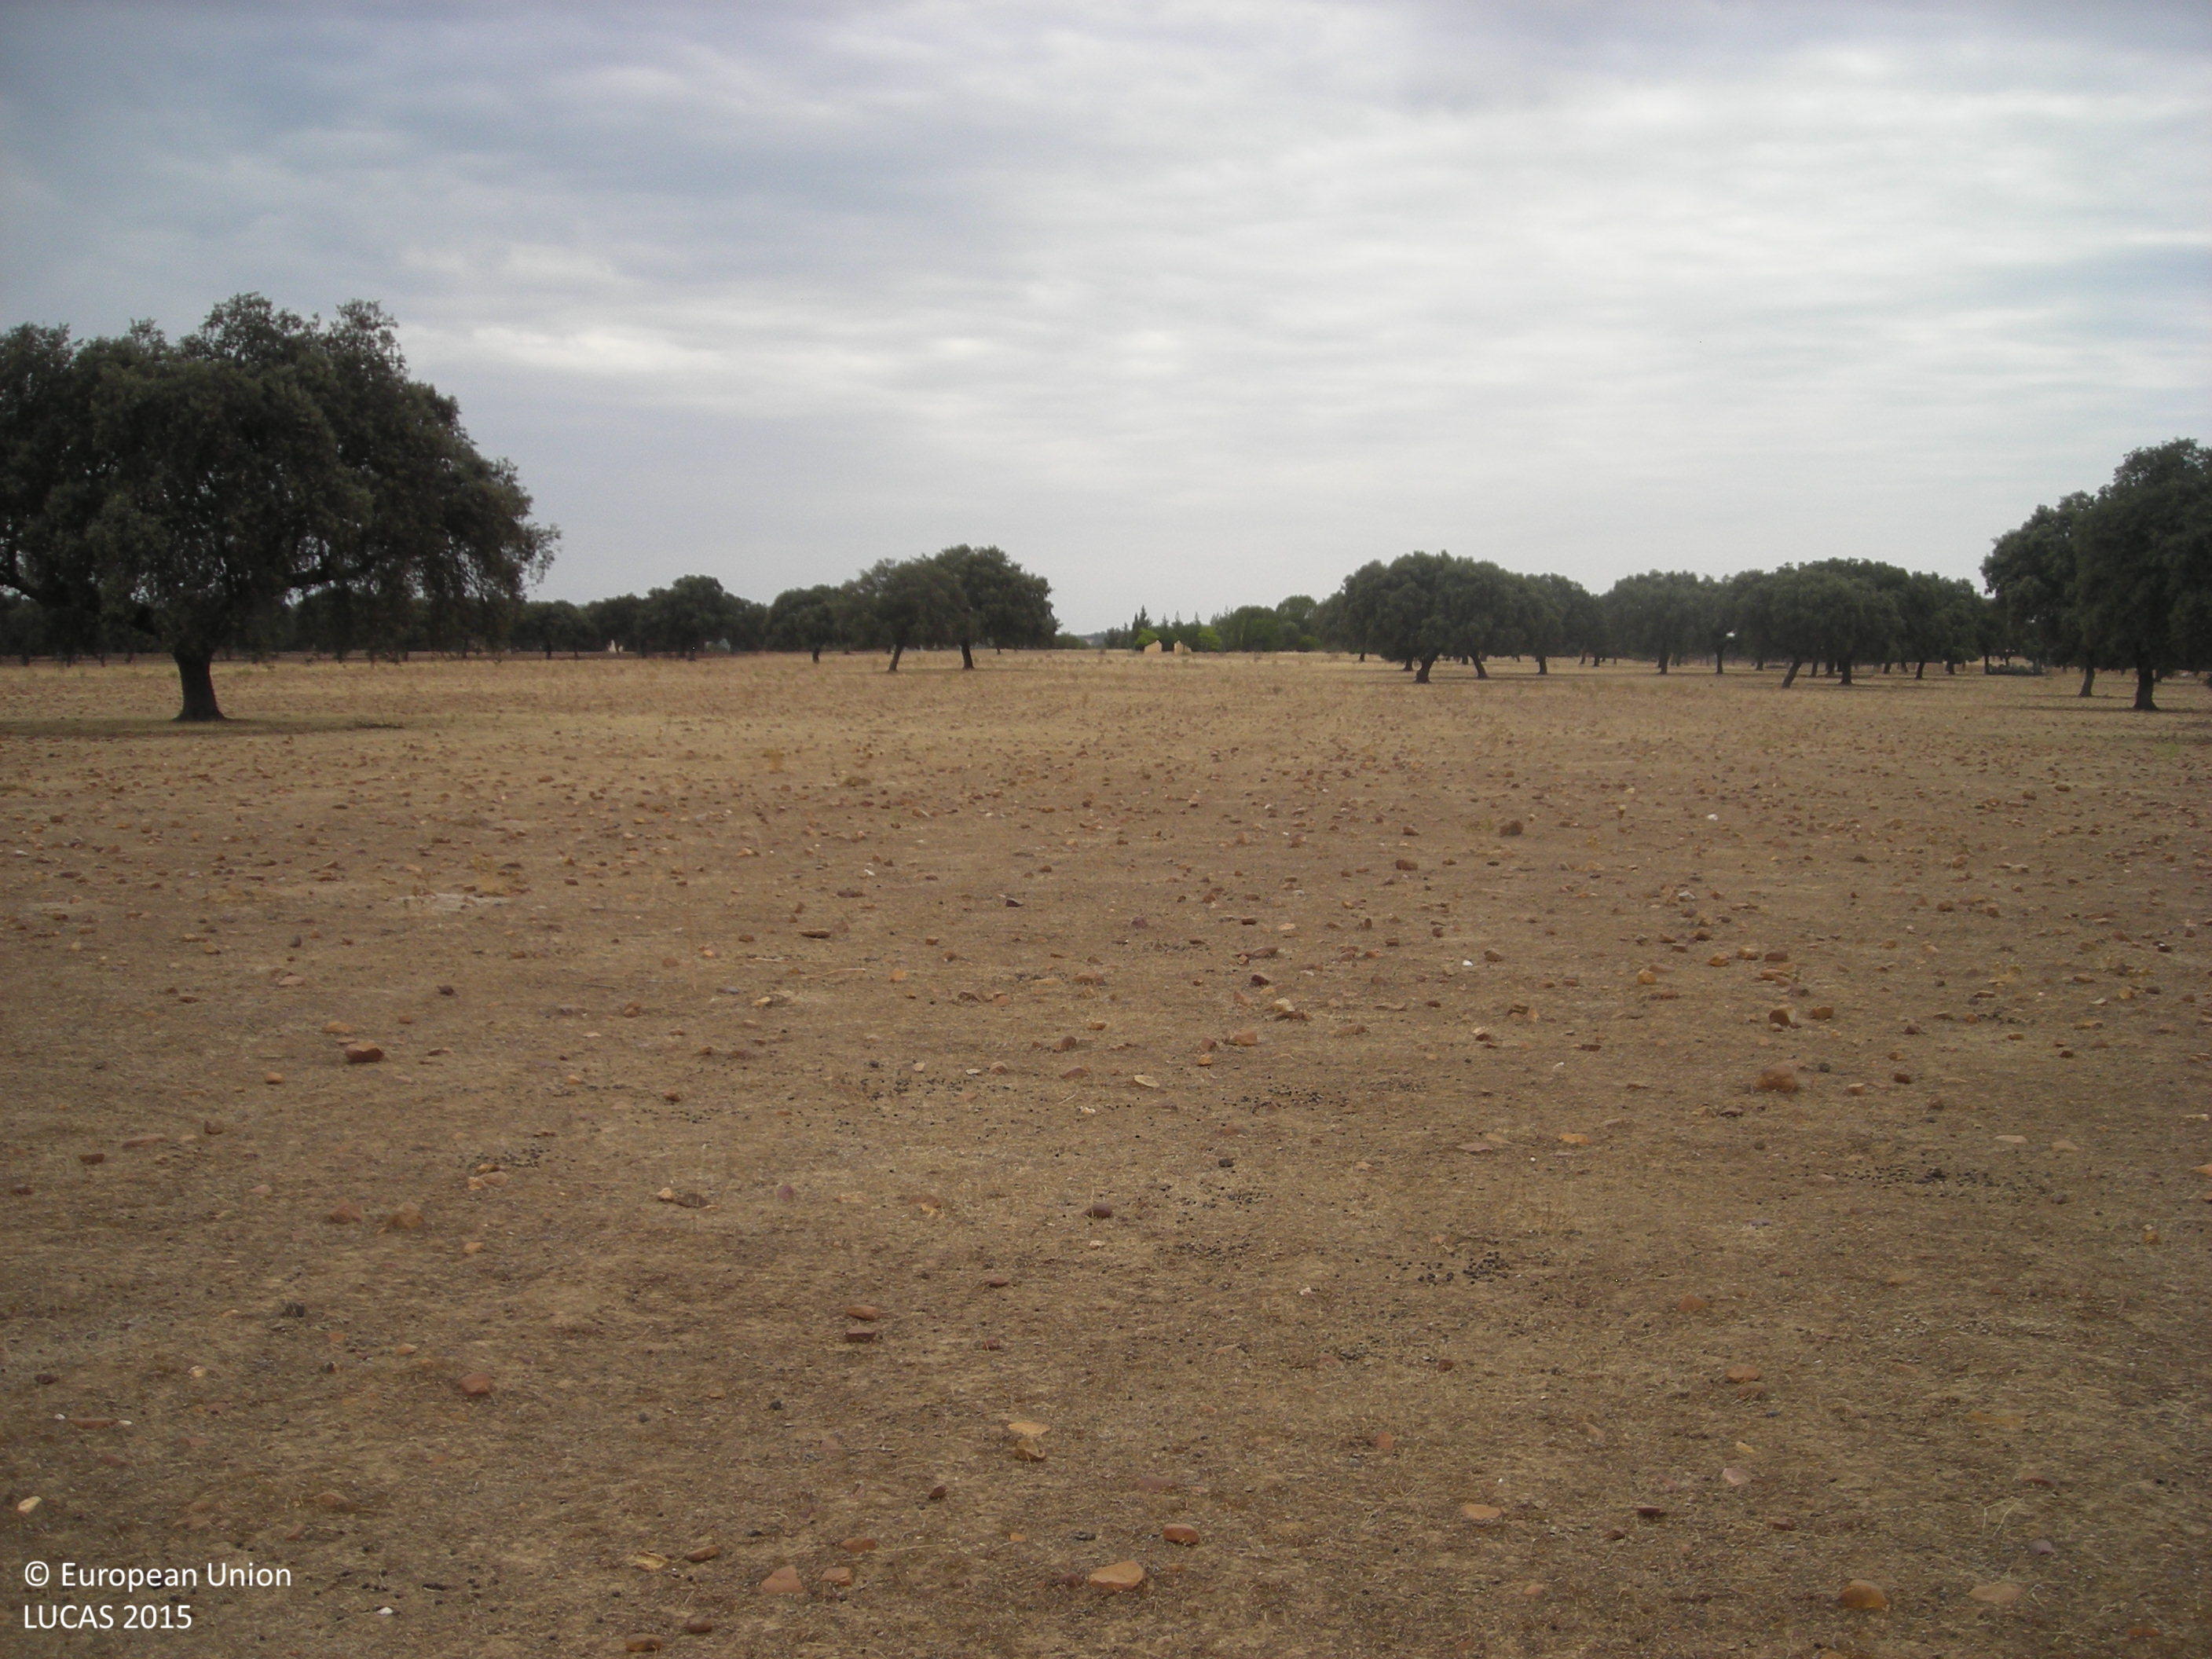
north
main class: Grassland
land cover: Grassland without tree/shrub cover
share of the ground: > 75 %
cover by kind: herbaceous plants 100 %
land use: Agriculture (excluding fallow land and kitchen gardens)
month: July
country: ES
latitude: 39.1743
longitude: -5.4994
